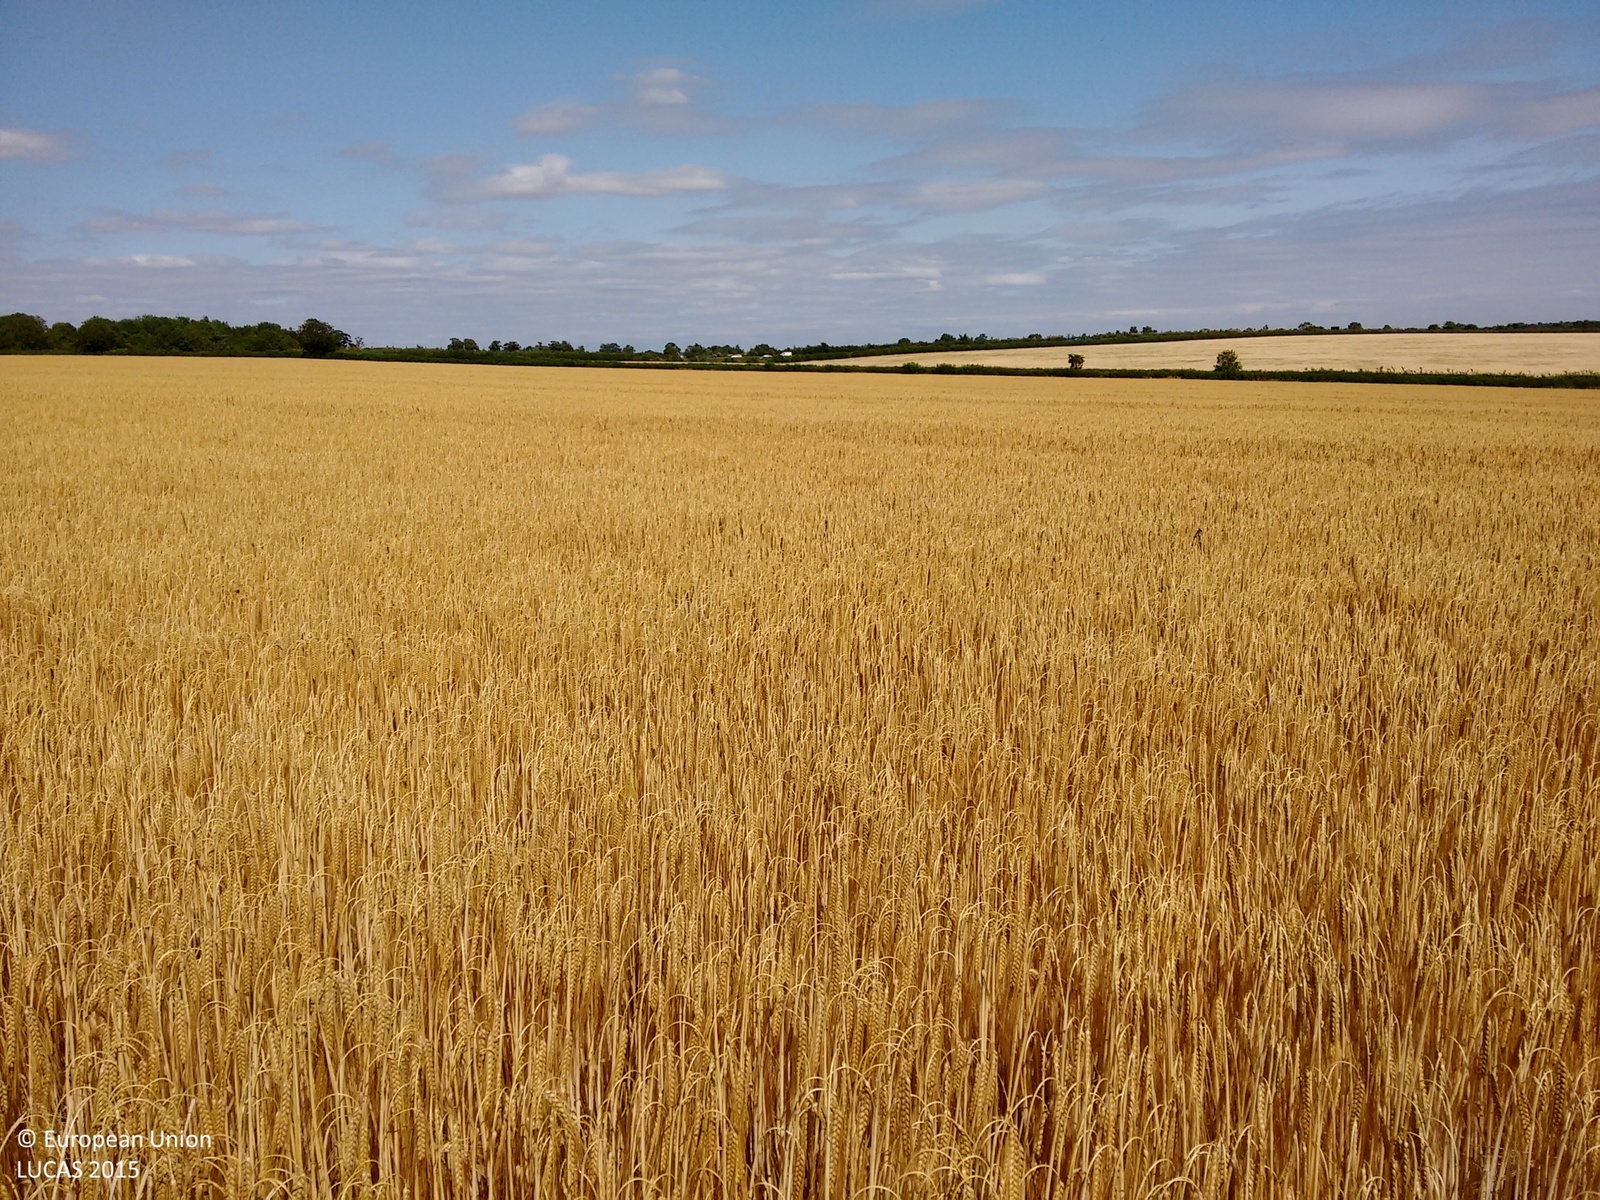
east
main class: Cropland
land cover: Barley
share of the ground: > 75 %
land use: Agriculture (excluding fallow land and kitchen gardens)
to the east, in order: Barley; Grass margins; Managed hedges; Grass margins; Paved roads, cycling and walking lanes; Grass margins; Managed hedges
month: July
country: GB
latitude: 52.6523
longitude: -0.5186
